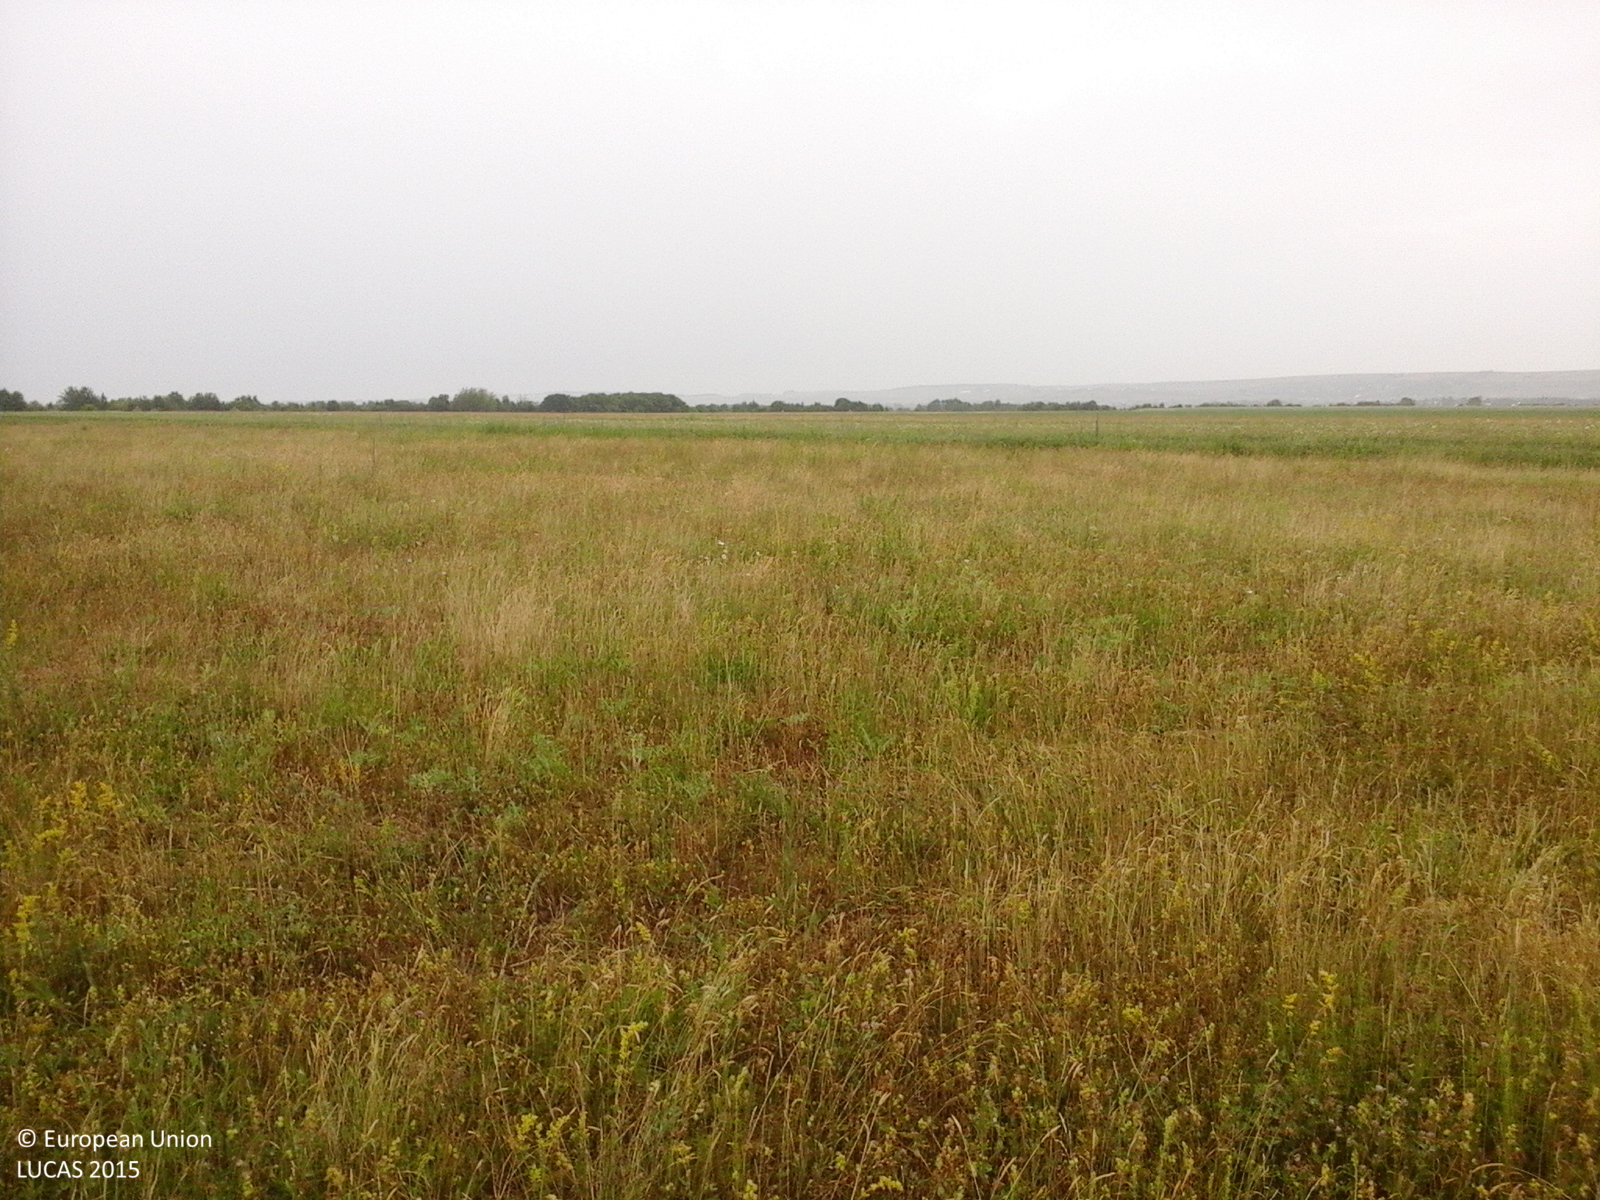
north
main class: Grassland
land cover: Spontaneously vegetated surfaces
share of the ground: 50 - 75 %
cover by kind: herbaceous plants 100 %
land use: Agriculture (excluding fallow land and kitchen gardens)
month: June
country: RO
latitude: 47.3231
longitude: 26.3443
